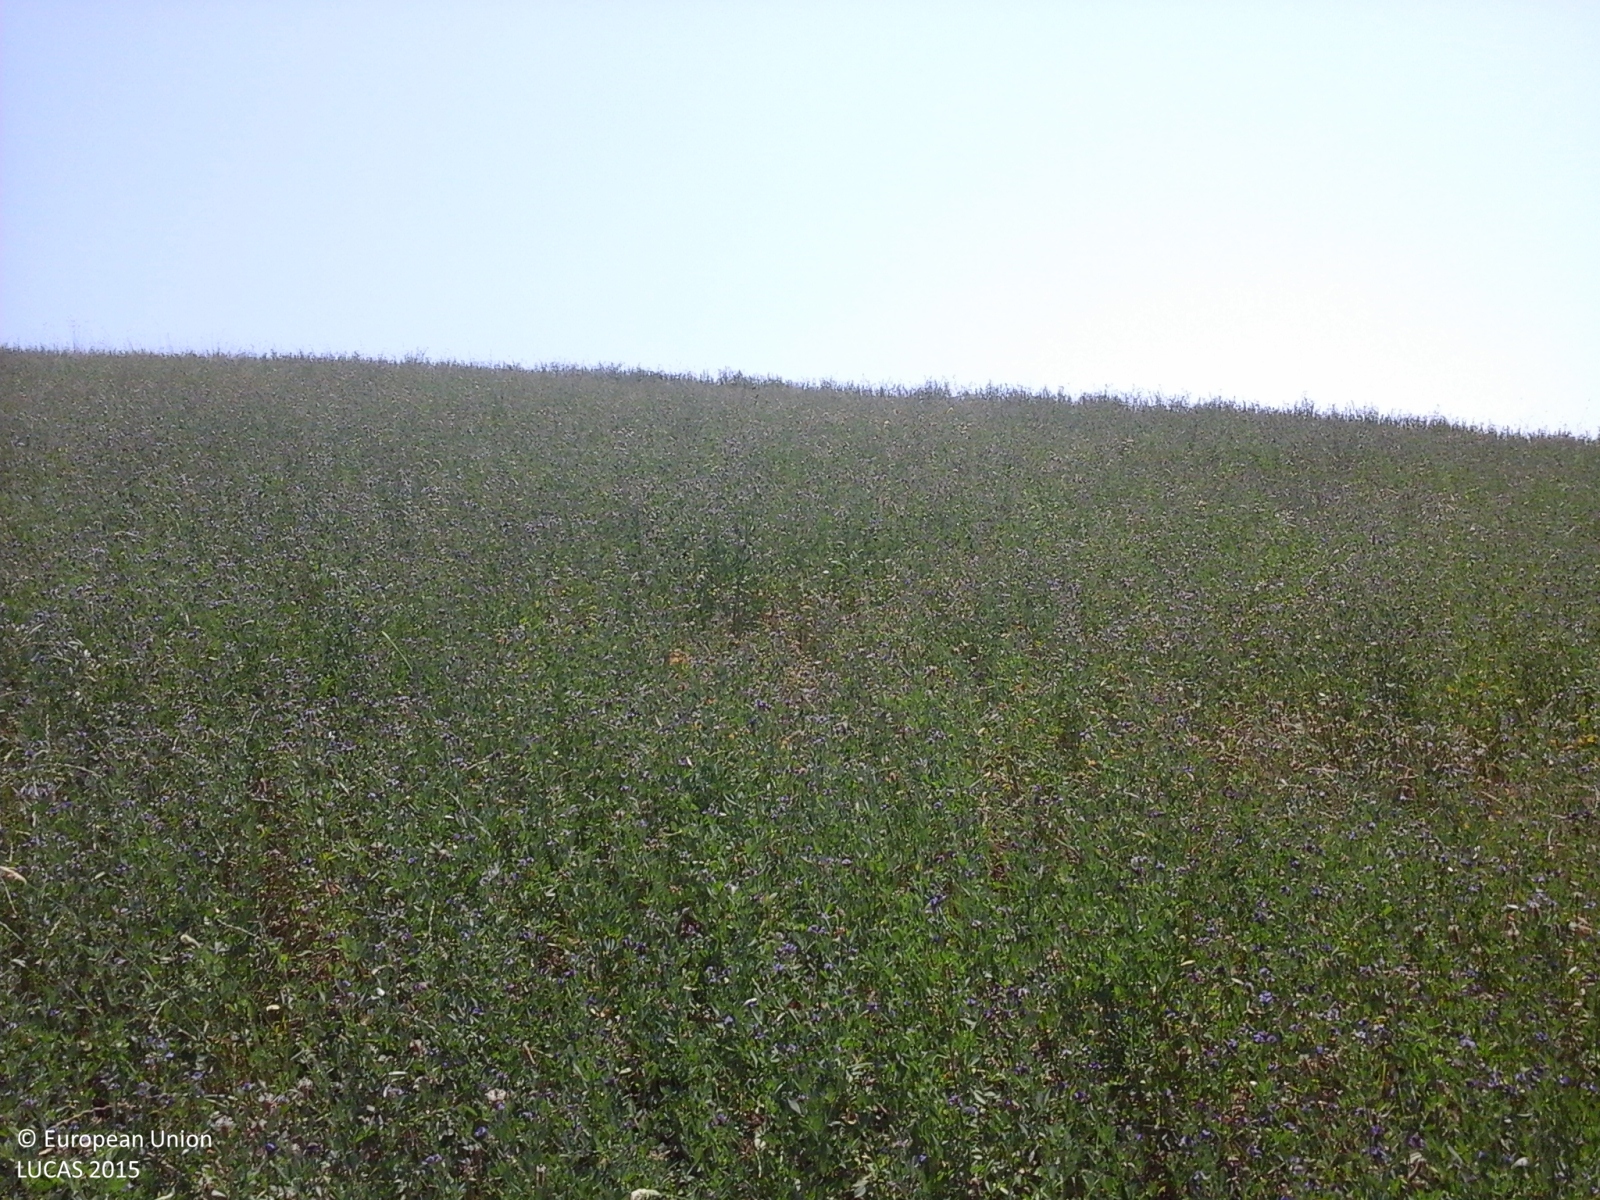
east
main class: Cropland
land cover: Lucerne
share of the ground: > 75 %
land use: Agriculture (excluding fallow land and kitchen gardens)
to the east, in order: Lucerne; Ditches and canals; Lucerne; Tracks; Other bare soil; Lucerne
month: July
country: IT
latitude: 44.2462
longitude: 11.7117
